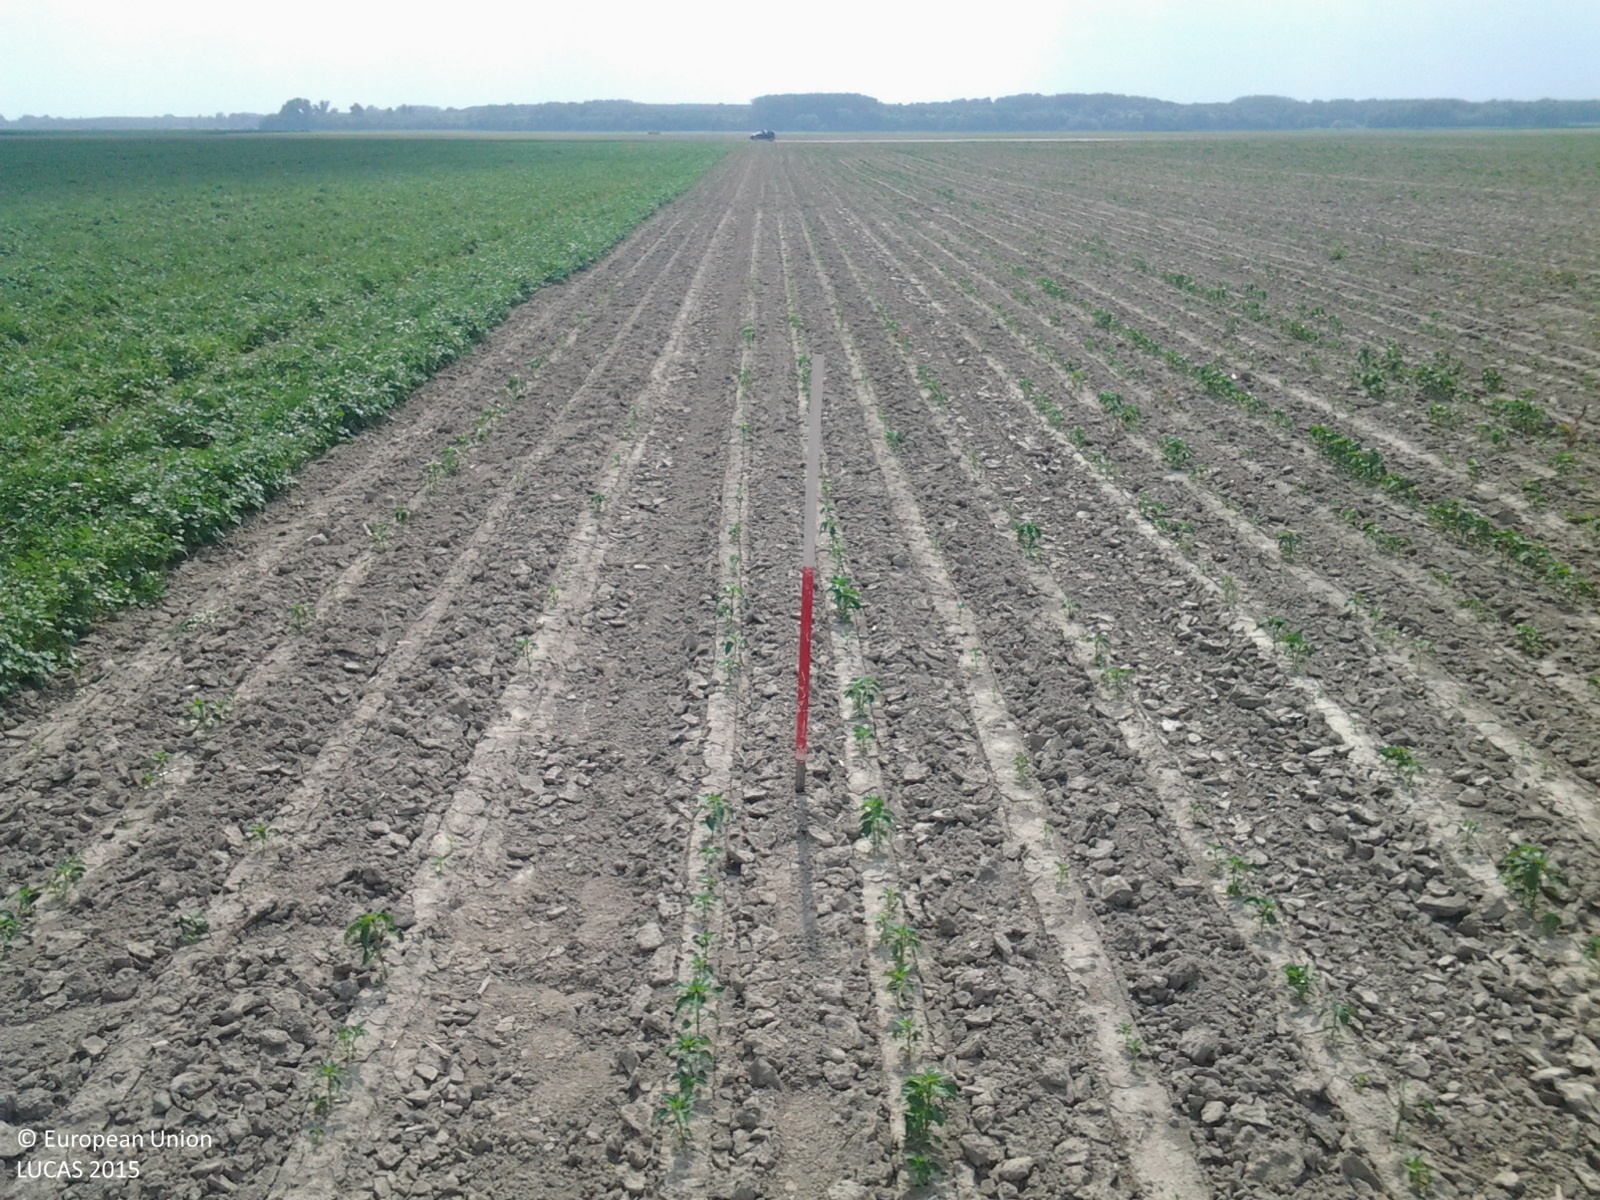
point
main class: Cropland
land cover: Other fresh vegetables
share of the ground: < 10 %
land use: Agriculture (excluding fallow land and kitchen gardens)
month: June
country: HU
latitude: 46.3945
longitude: 18.9212
